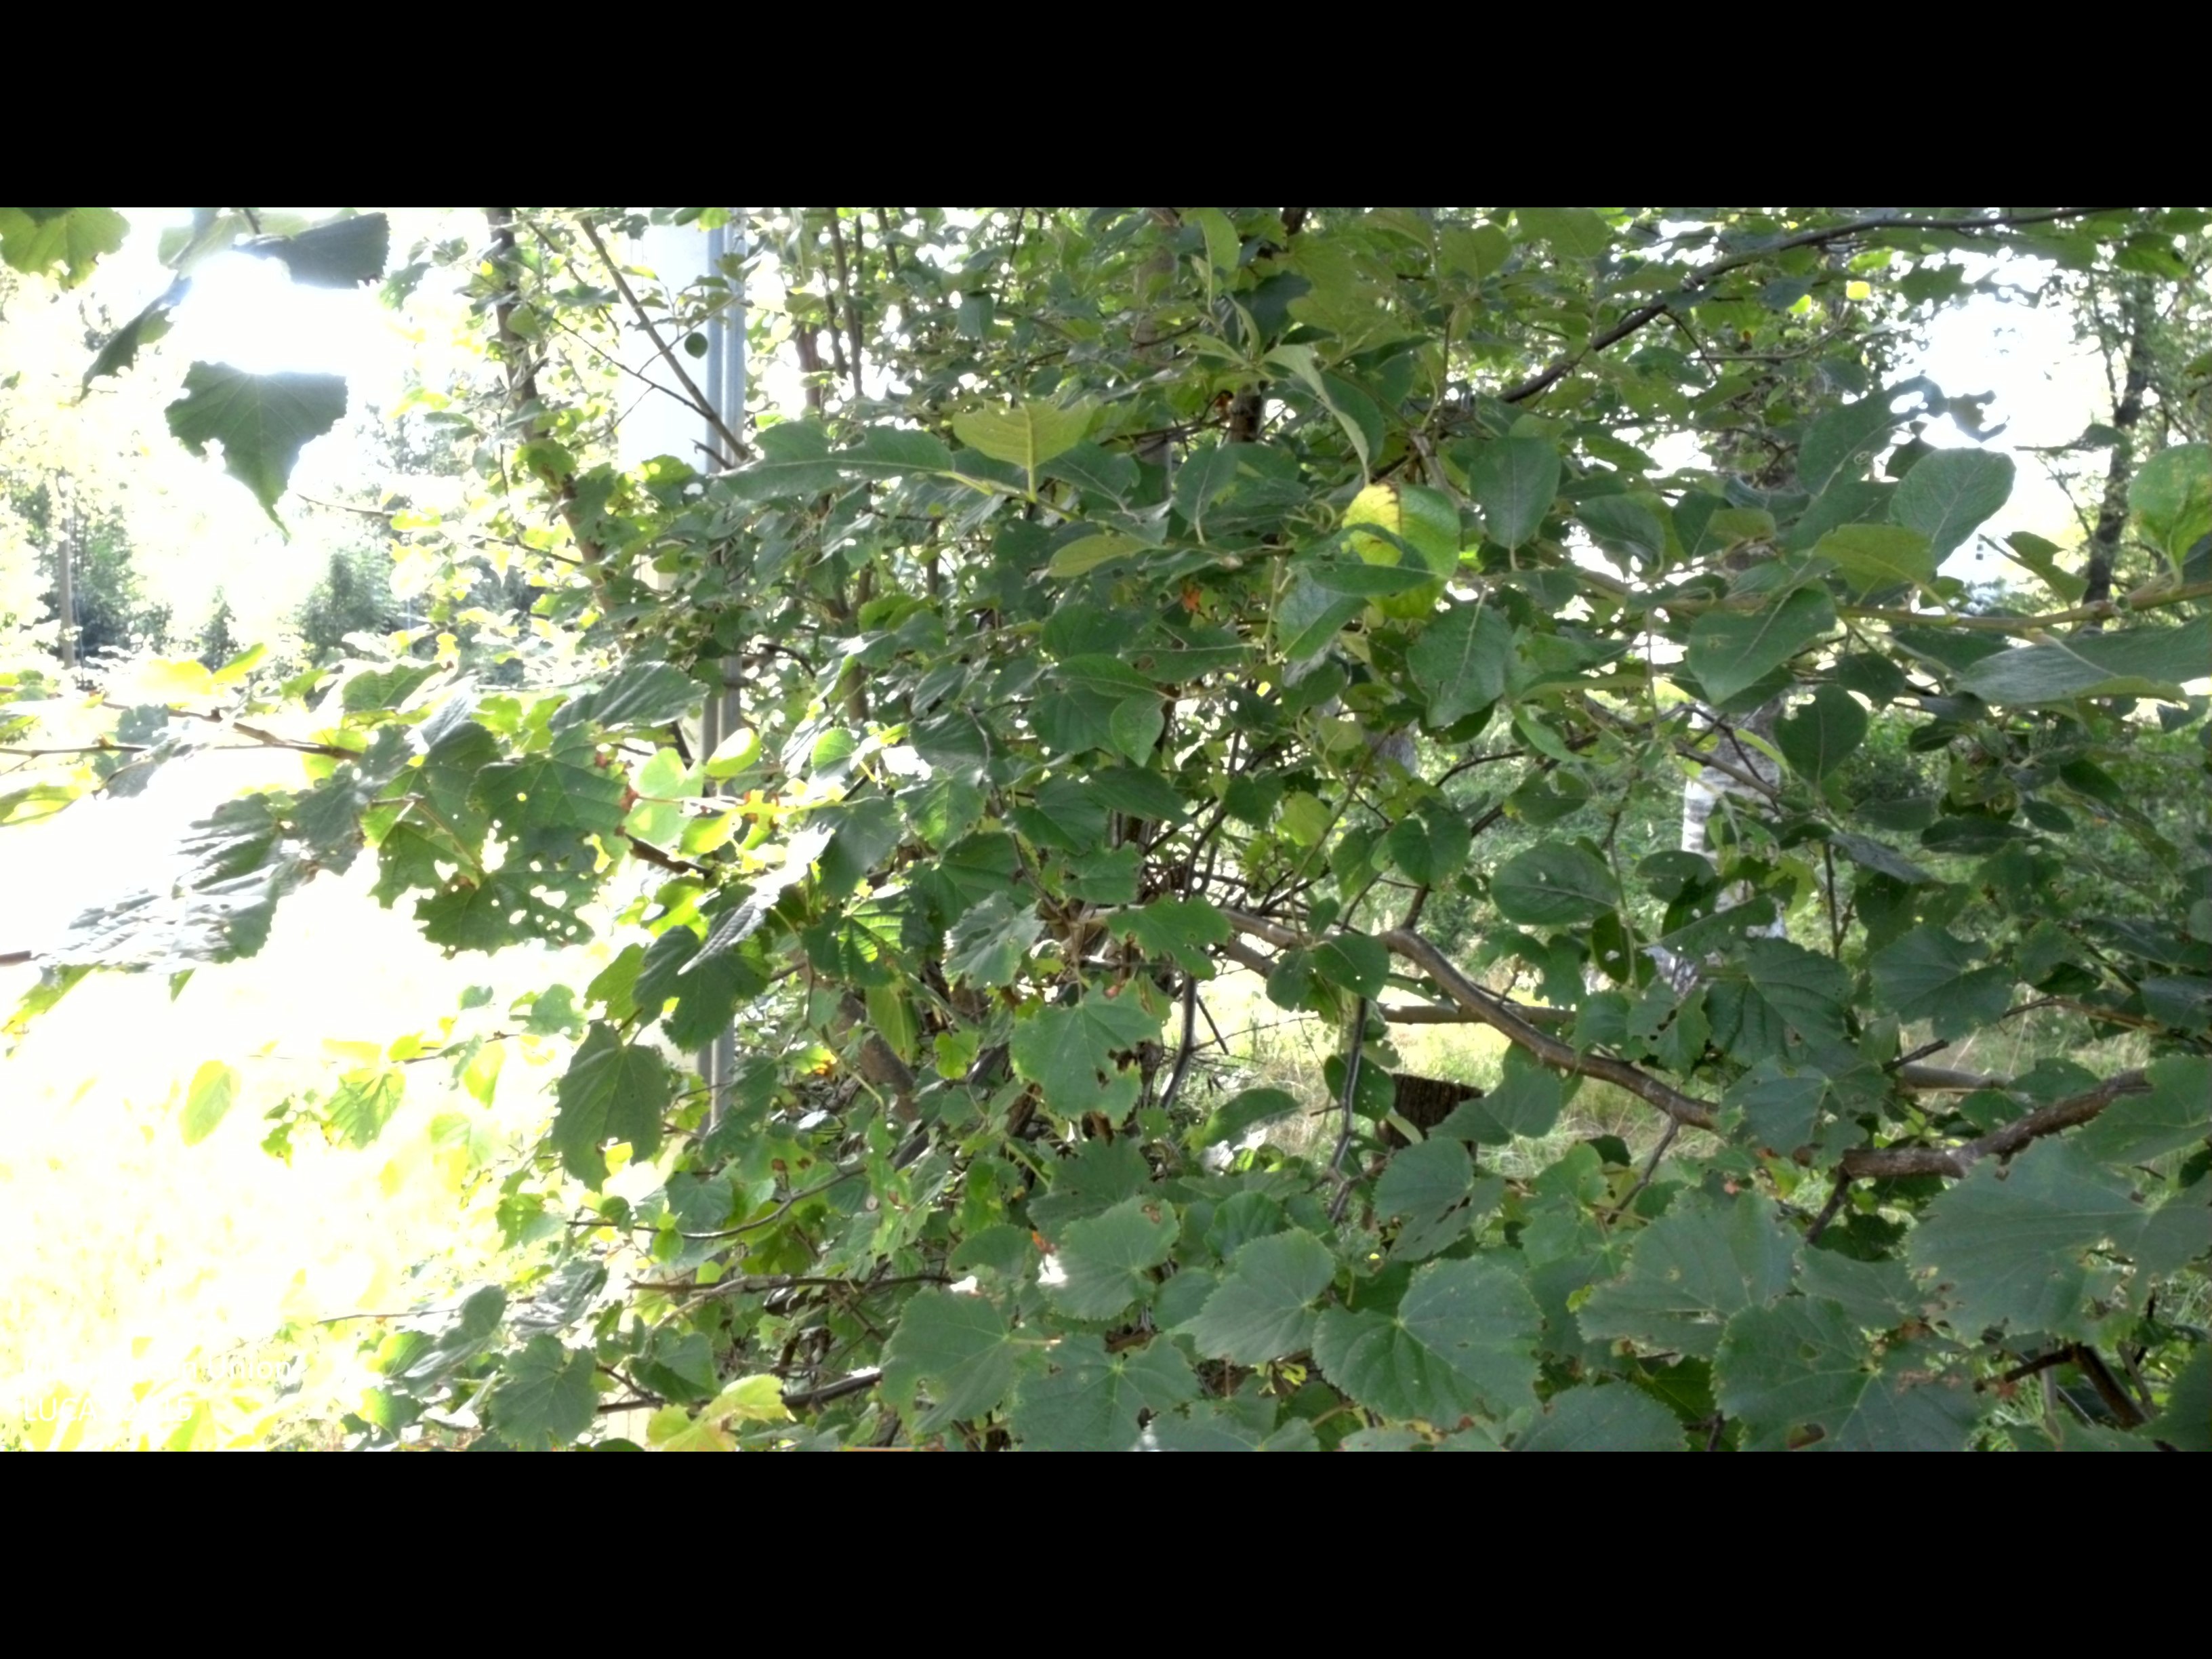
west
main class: Woodland
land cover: Broadleaved woodland
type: boreal forest
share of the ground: 50 - 75 %
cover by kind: broadleaved forest trees 60 %, herbaceous plants 30 %, shrubs 10 %
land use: Residential
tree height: > 5 m
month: August
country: SE
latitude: 56.8221
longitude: 14.1748
